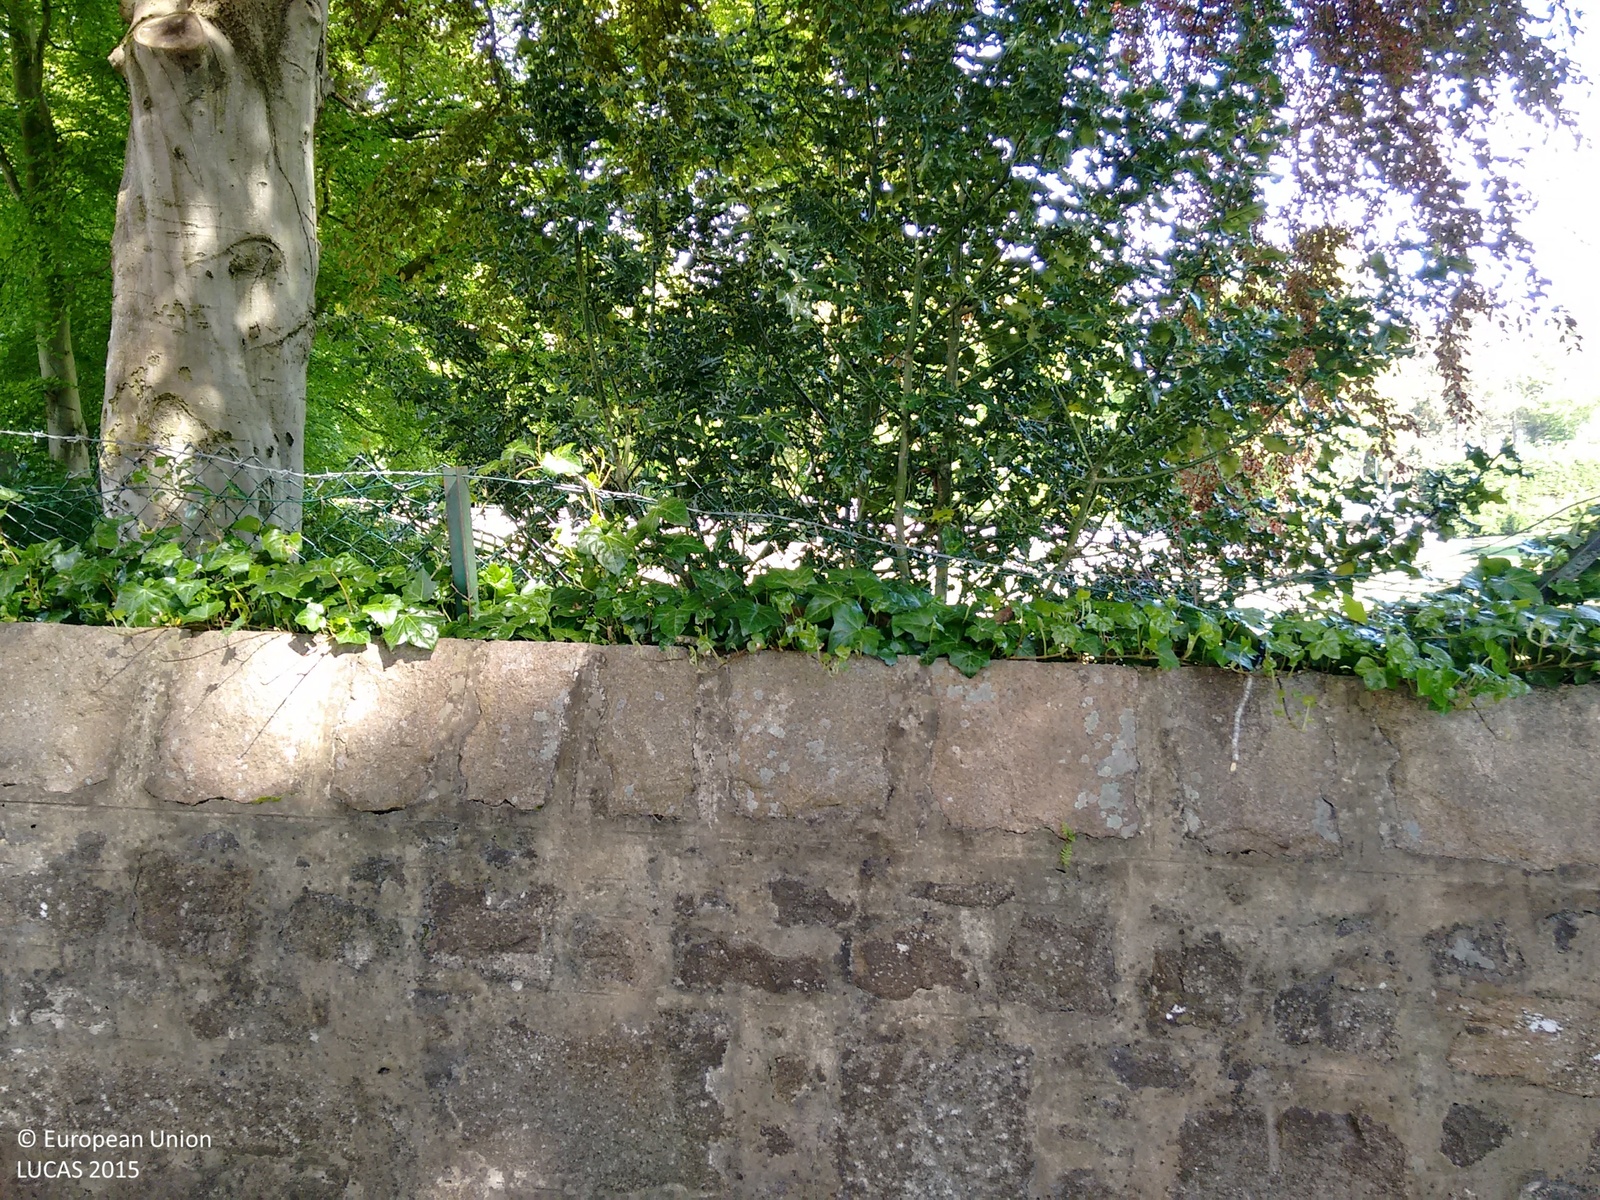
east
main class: Grassland
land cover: Grassland without tree/shrub cover
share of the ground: > 75 %
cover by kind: herbaceous plants 100 %
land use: Residential
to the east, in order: Grassland without tree/shrub cover; Single bushes/trees; Grassland without tree/shrub cover; Fences; Broadleaved woodland; Artificial constructions in urban areas; Broadleaved woodland; Grassland without tree/shrub cover
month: June
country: GB
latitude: 57.1188
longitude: -2.1549
